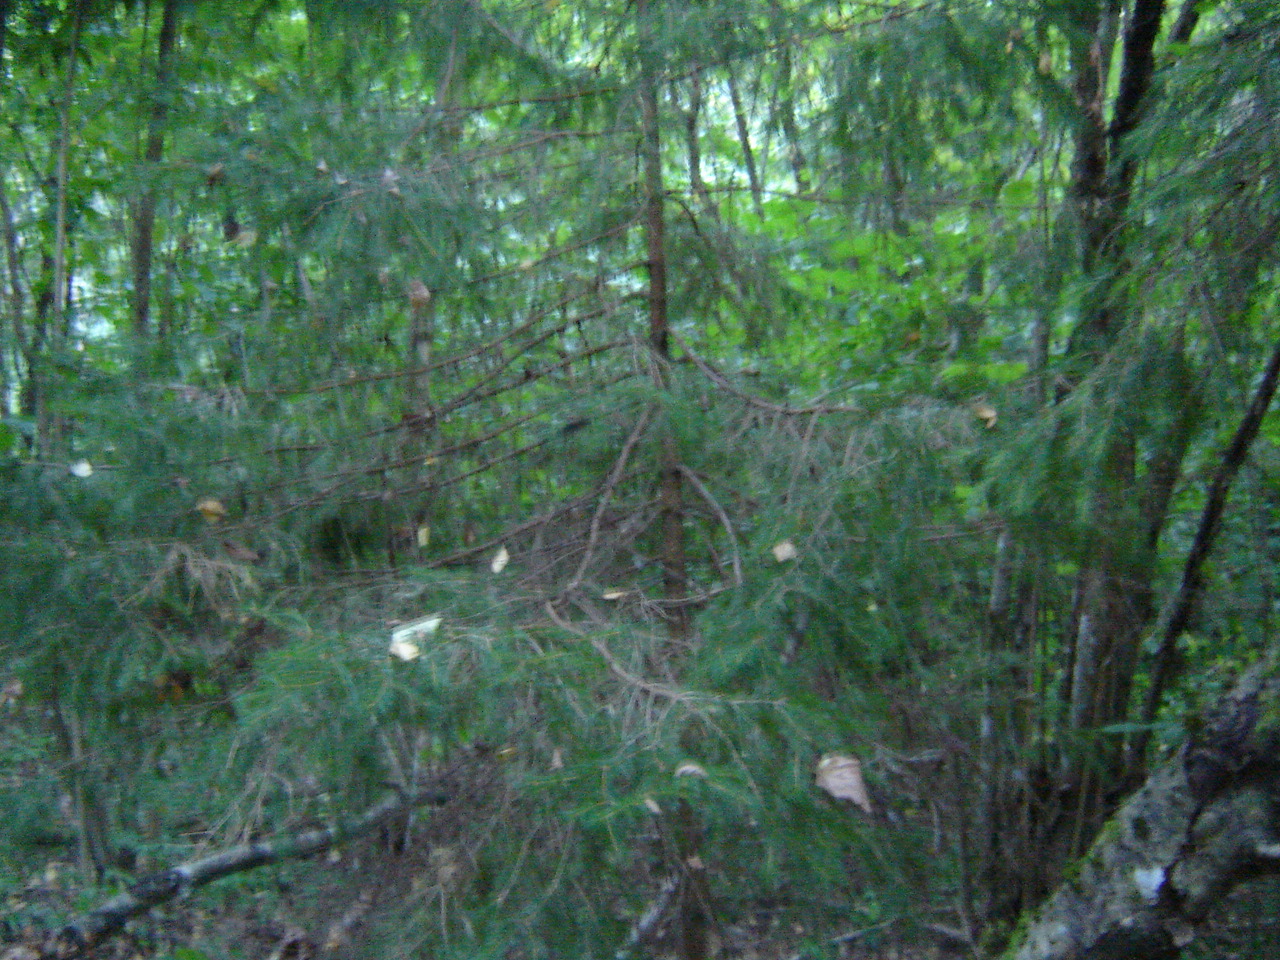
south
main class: Woodland
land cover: Spruce dominated mixed woodland
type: hemiboreal forest and nemoral coniferous forest and mixed broadleaved-coniferous forest
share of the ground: > 75 %
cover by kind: coniferous forest trees 55 %, broadleaved forest trees 35 %, herbaceous plants 10 %
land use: Forestry
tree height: > 5 m
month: August
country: LT
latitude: 54.7023
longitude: 24.9325
